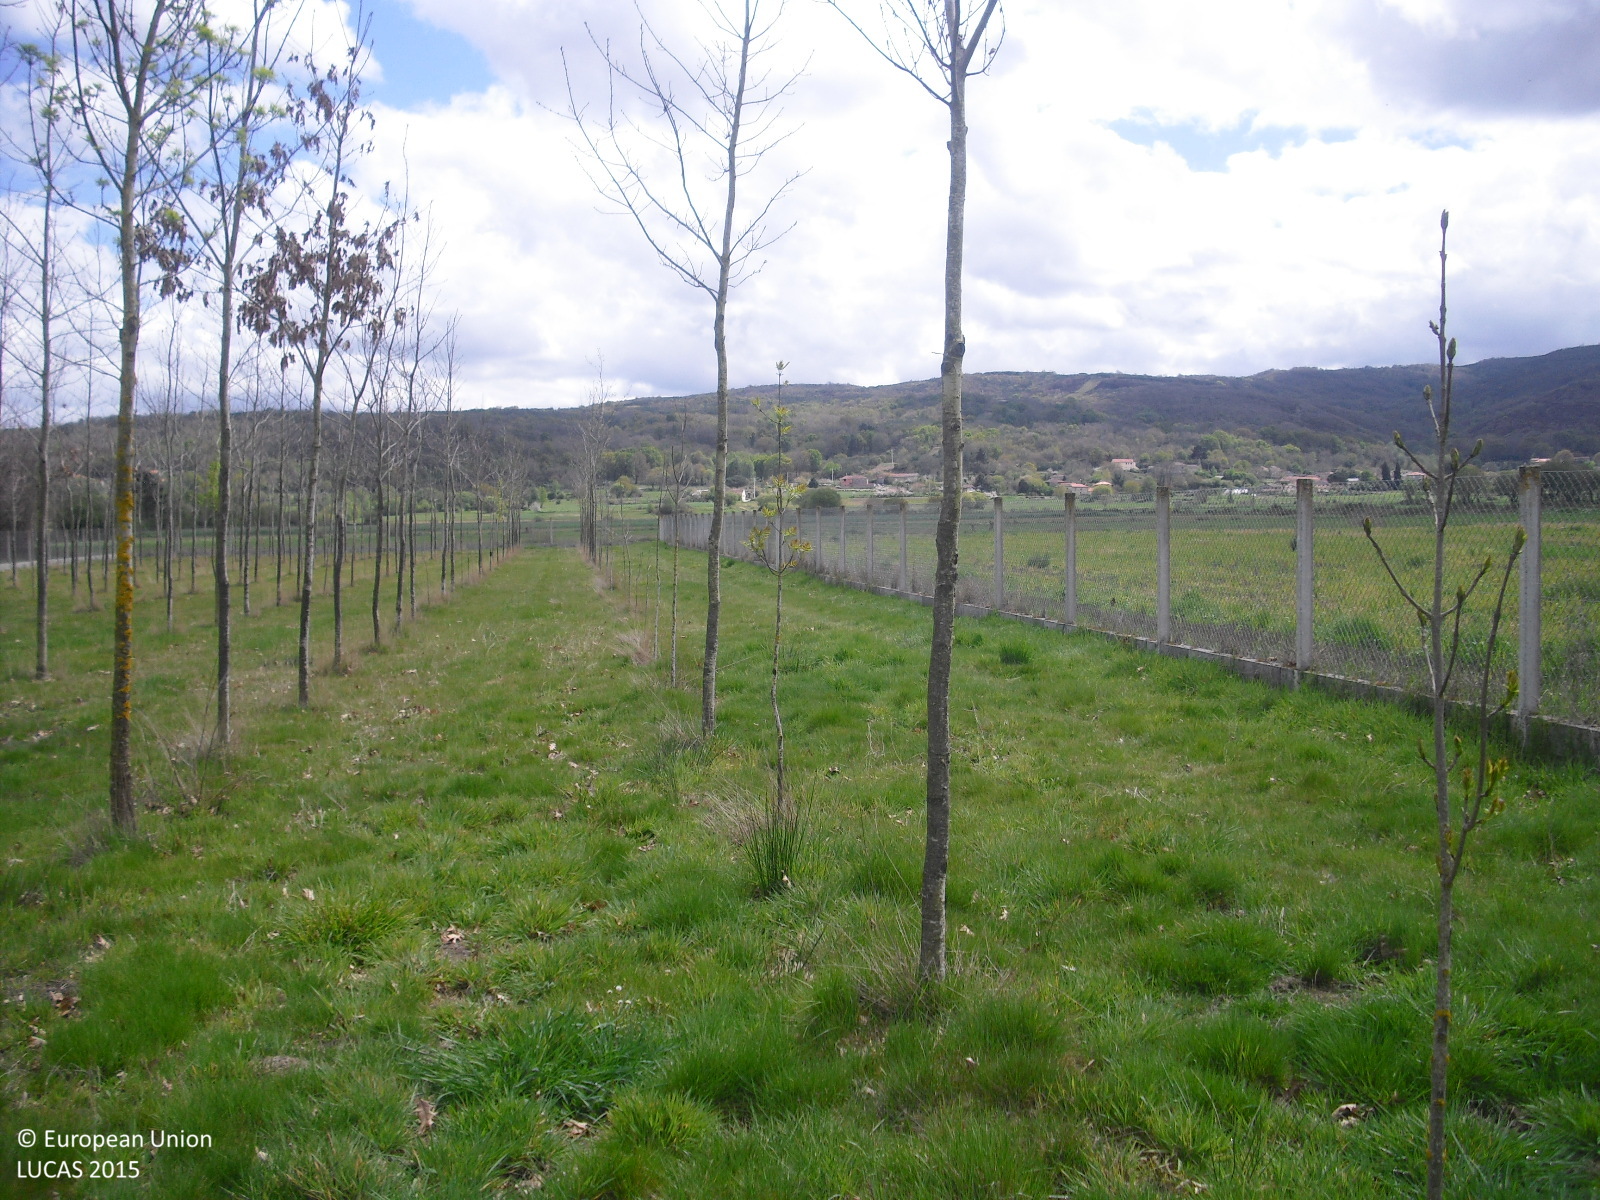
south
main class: Woodland
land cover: Broadleaved woodland
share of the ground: 10 - 25 %
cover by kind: herbaceous plants 80 %, broadleaved forest trees 20 %
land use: Forestry
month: April
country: ES
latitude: 42.0371
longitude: -7.8168
